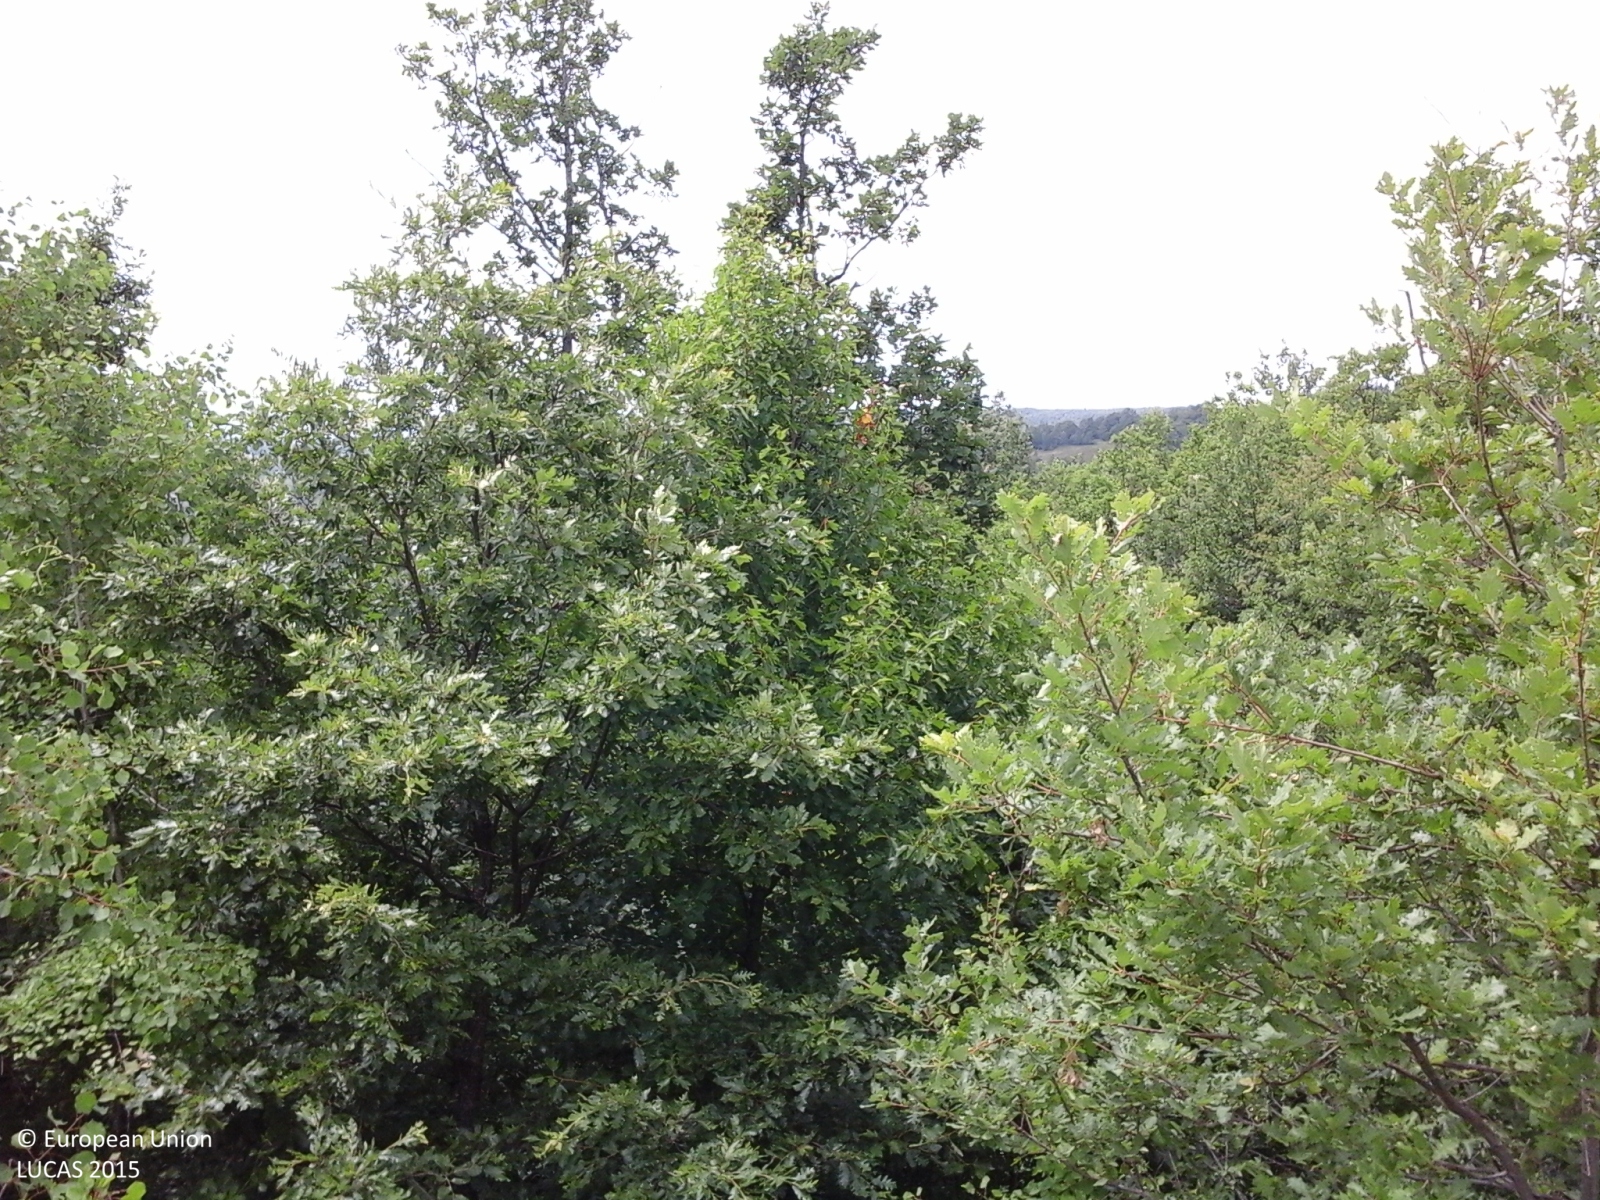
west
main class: Woodland
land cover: Broadleaved woodland
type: thermophilous deciduous forest
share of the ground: > 75 %
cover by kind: broadleaved forest trees 100 %
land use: Forestry
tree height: > 5 m
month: June
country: IT
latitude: 44.6926
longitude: 9.6348
